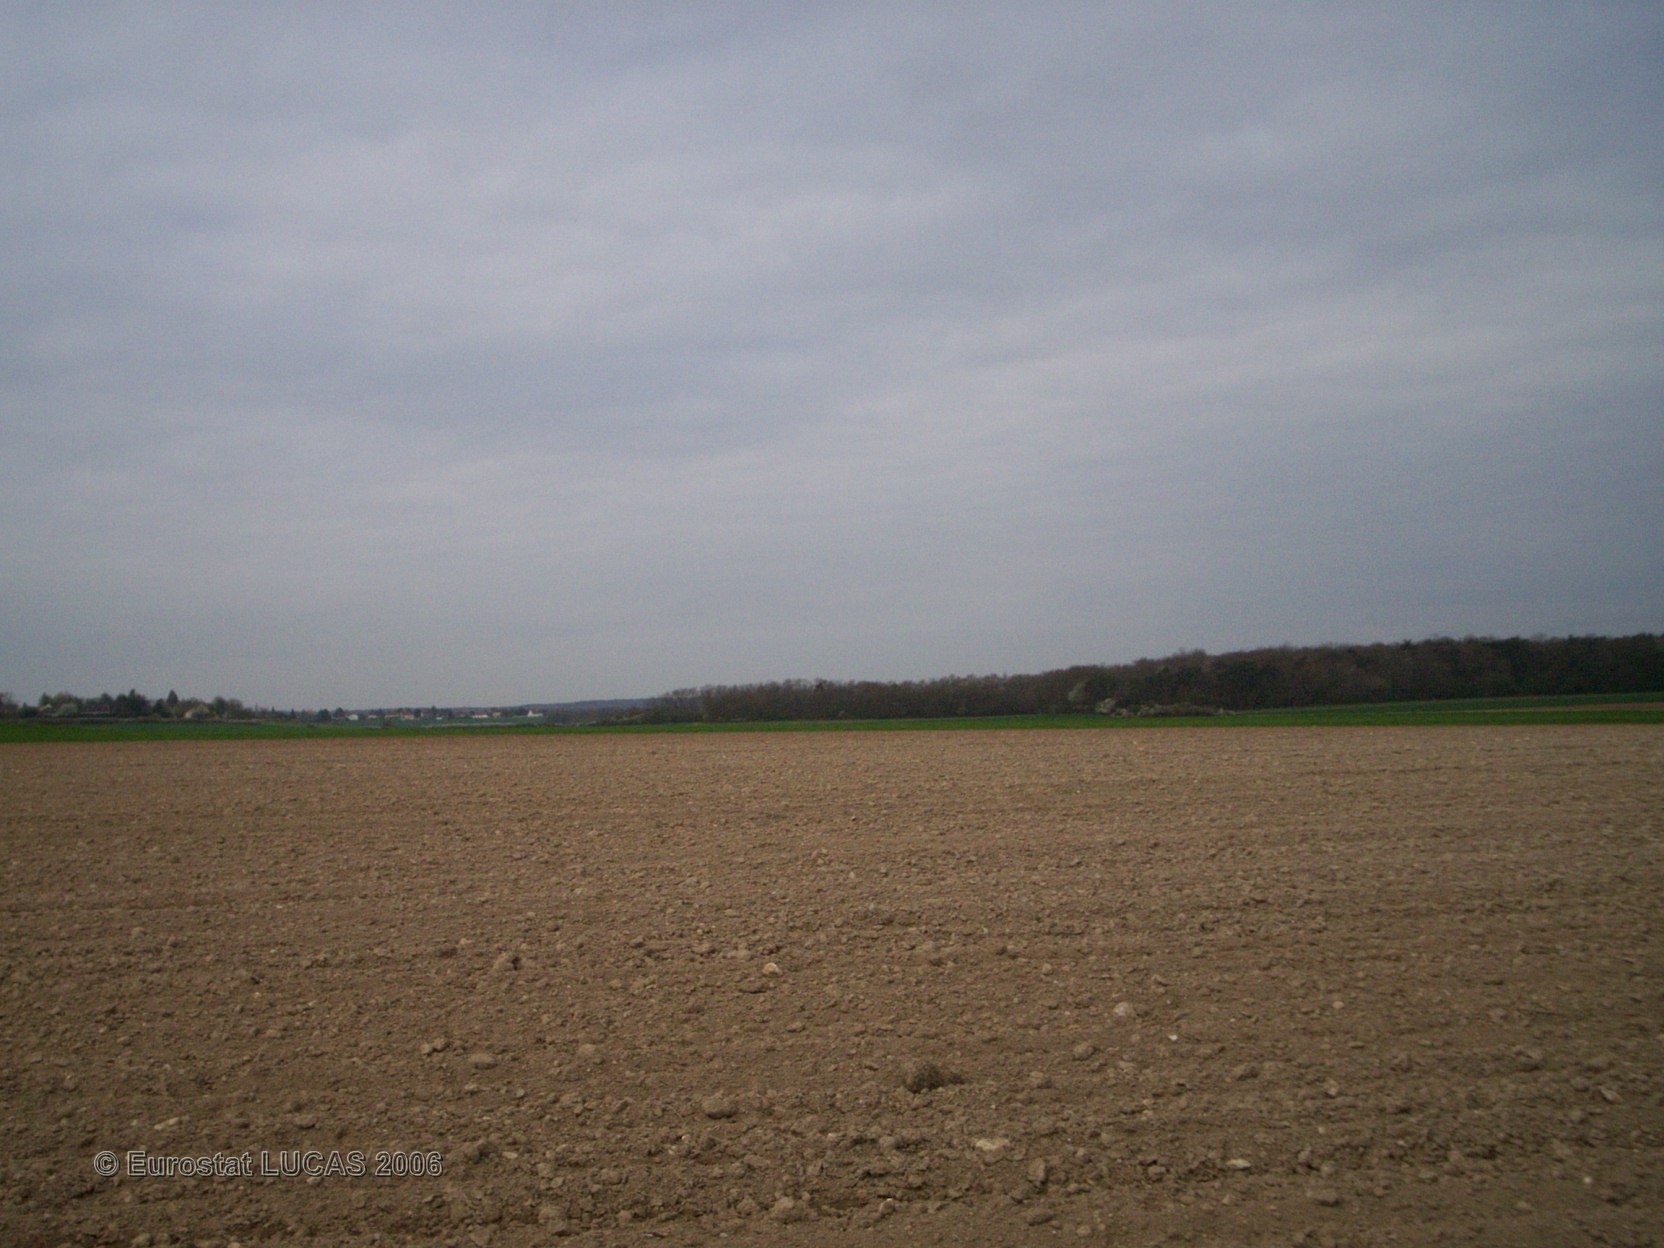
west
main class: Cropland
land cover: Sunflower
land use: Agriculture (excluding fallow land and kitchen gardens)
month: May
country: FR
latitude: 48.2794
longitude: 2.8361
